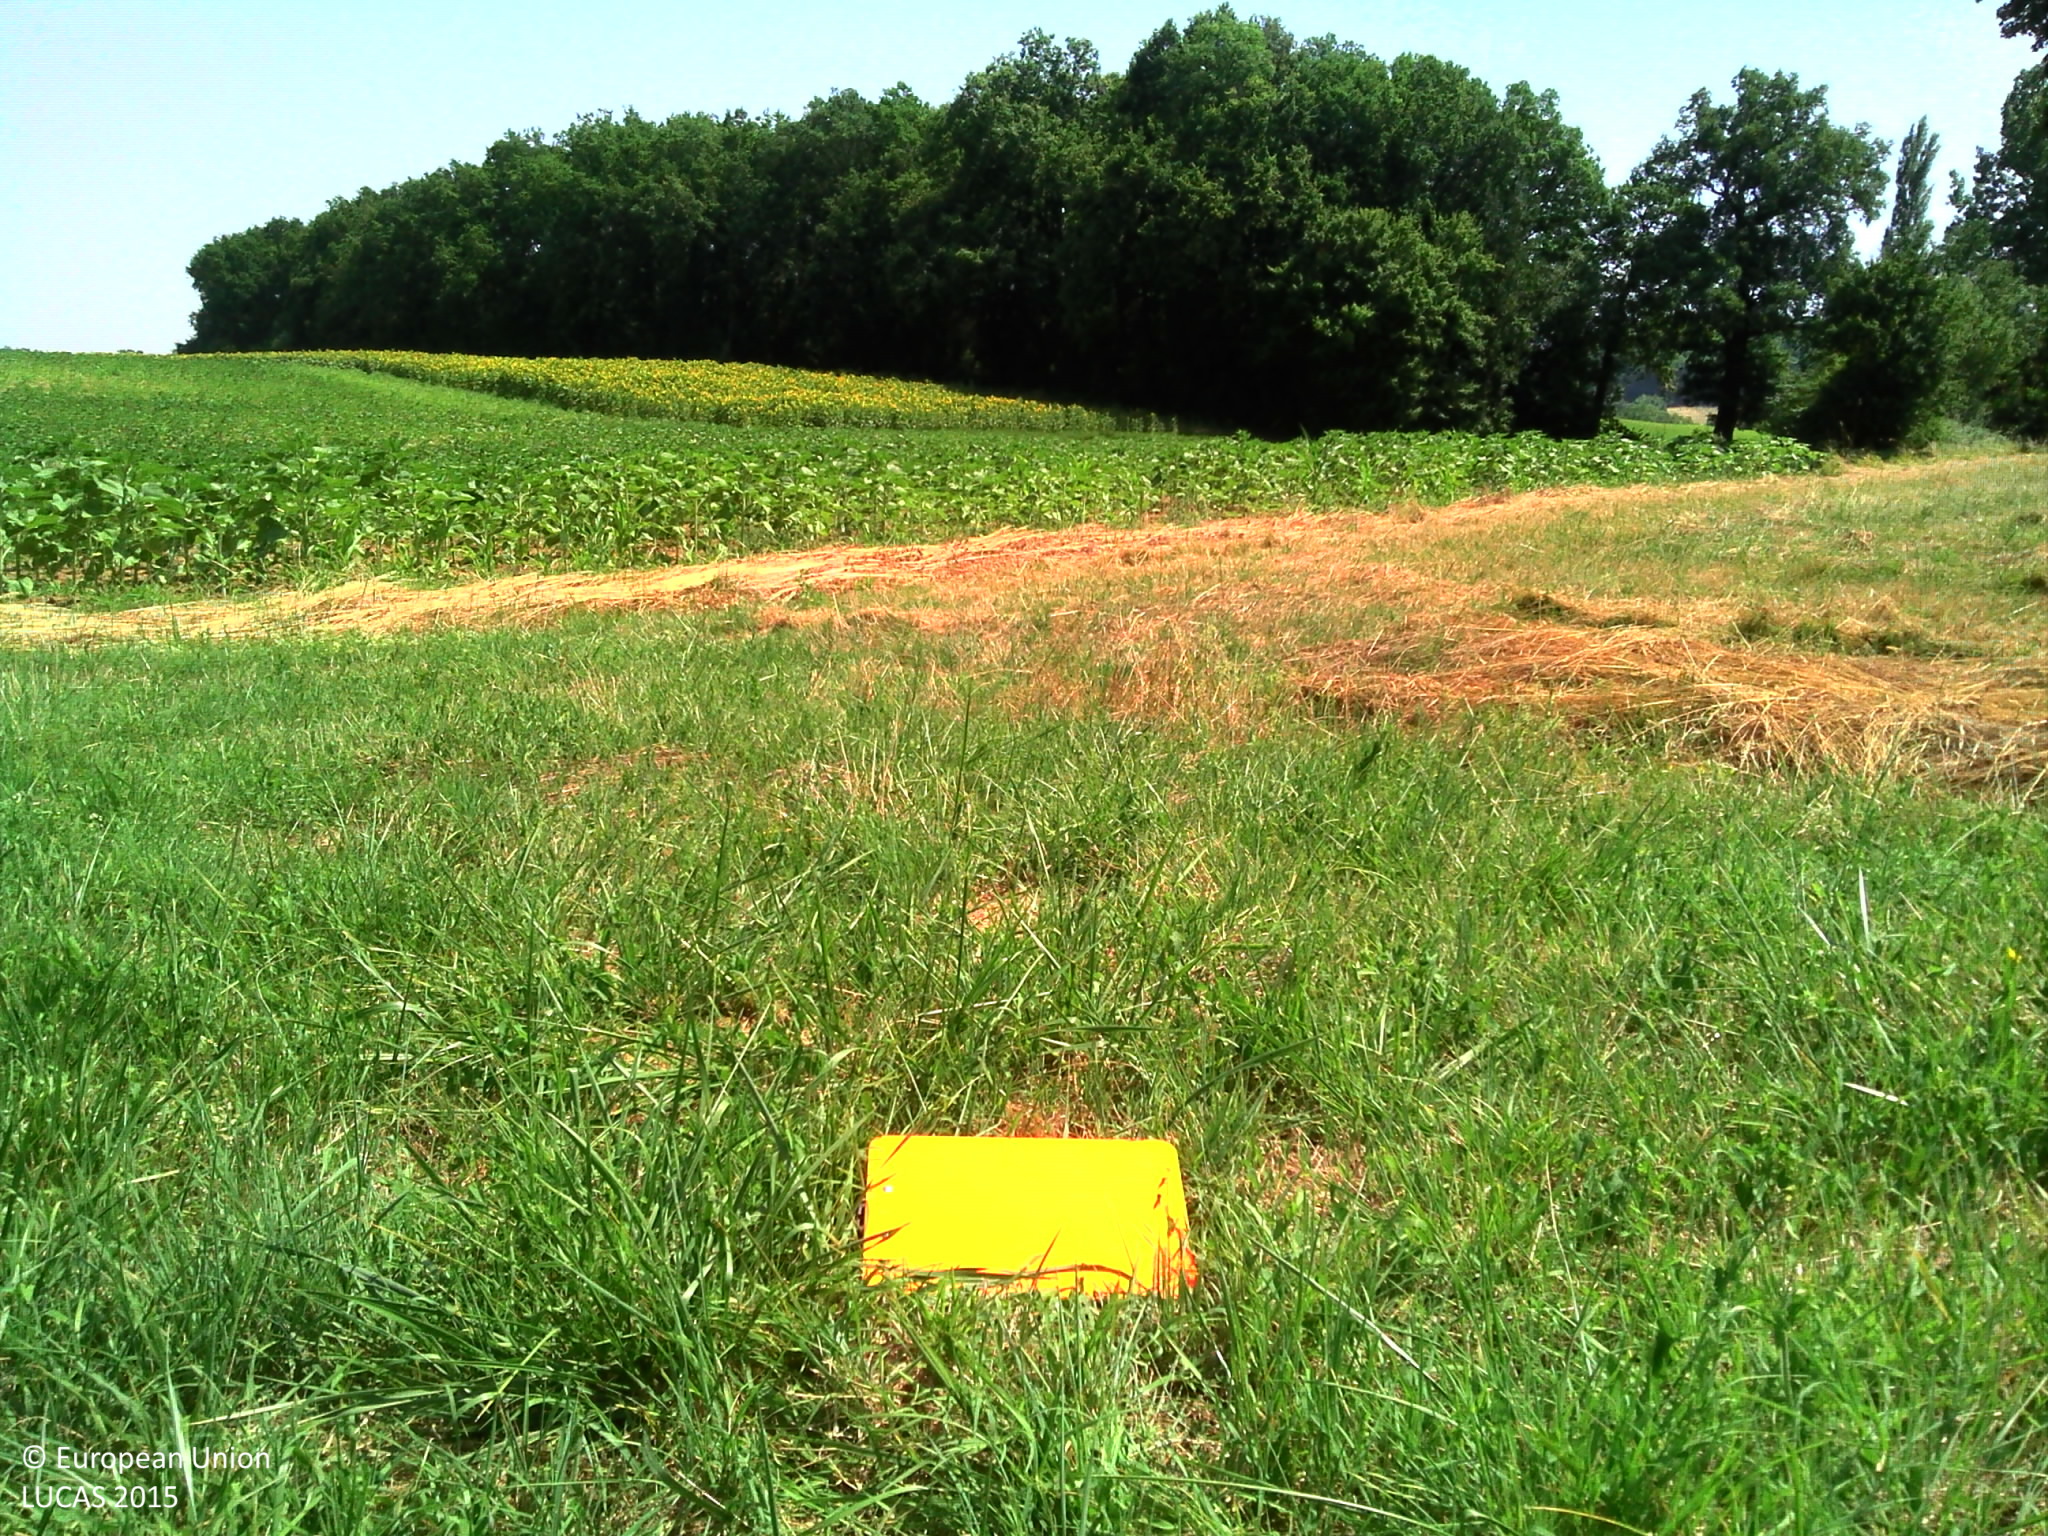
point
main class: Grassland
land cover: Grassland without tree/shrub cover
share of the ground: > 75 %
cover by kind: herbaceous plants 100 %
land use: Agriculture (excluding fallow land and kitchen gardens)
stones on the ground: < 10 %
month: July
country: FR
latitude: 44.4543
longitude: 0.8585
